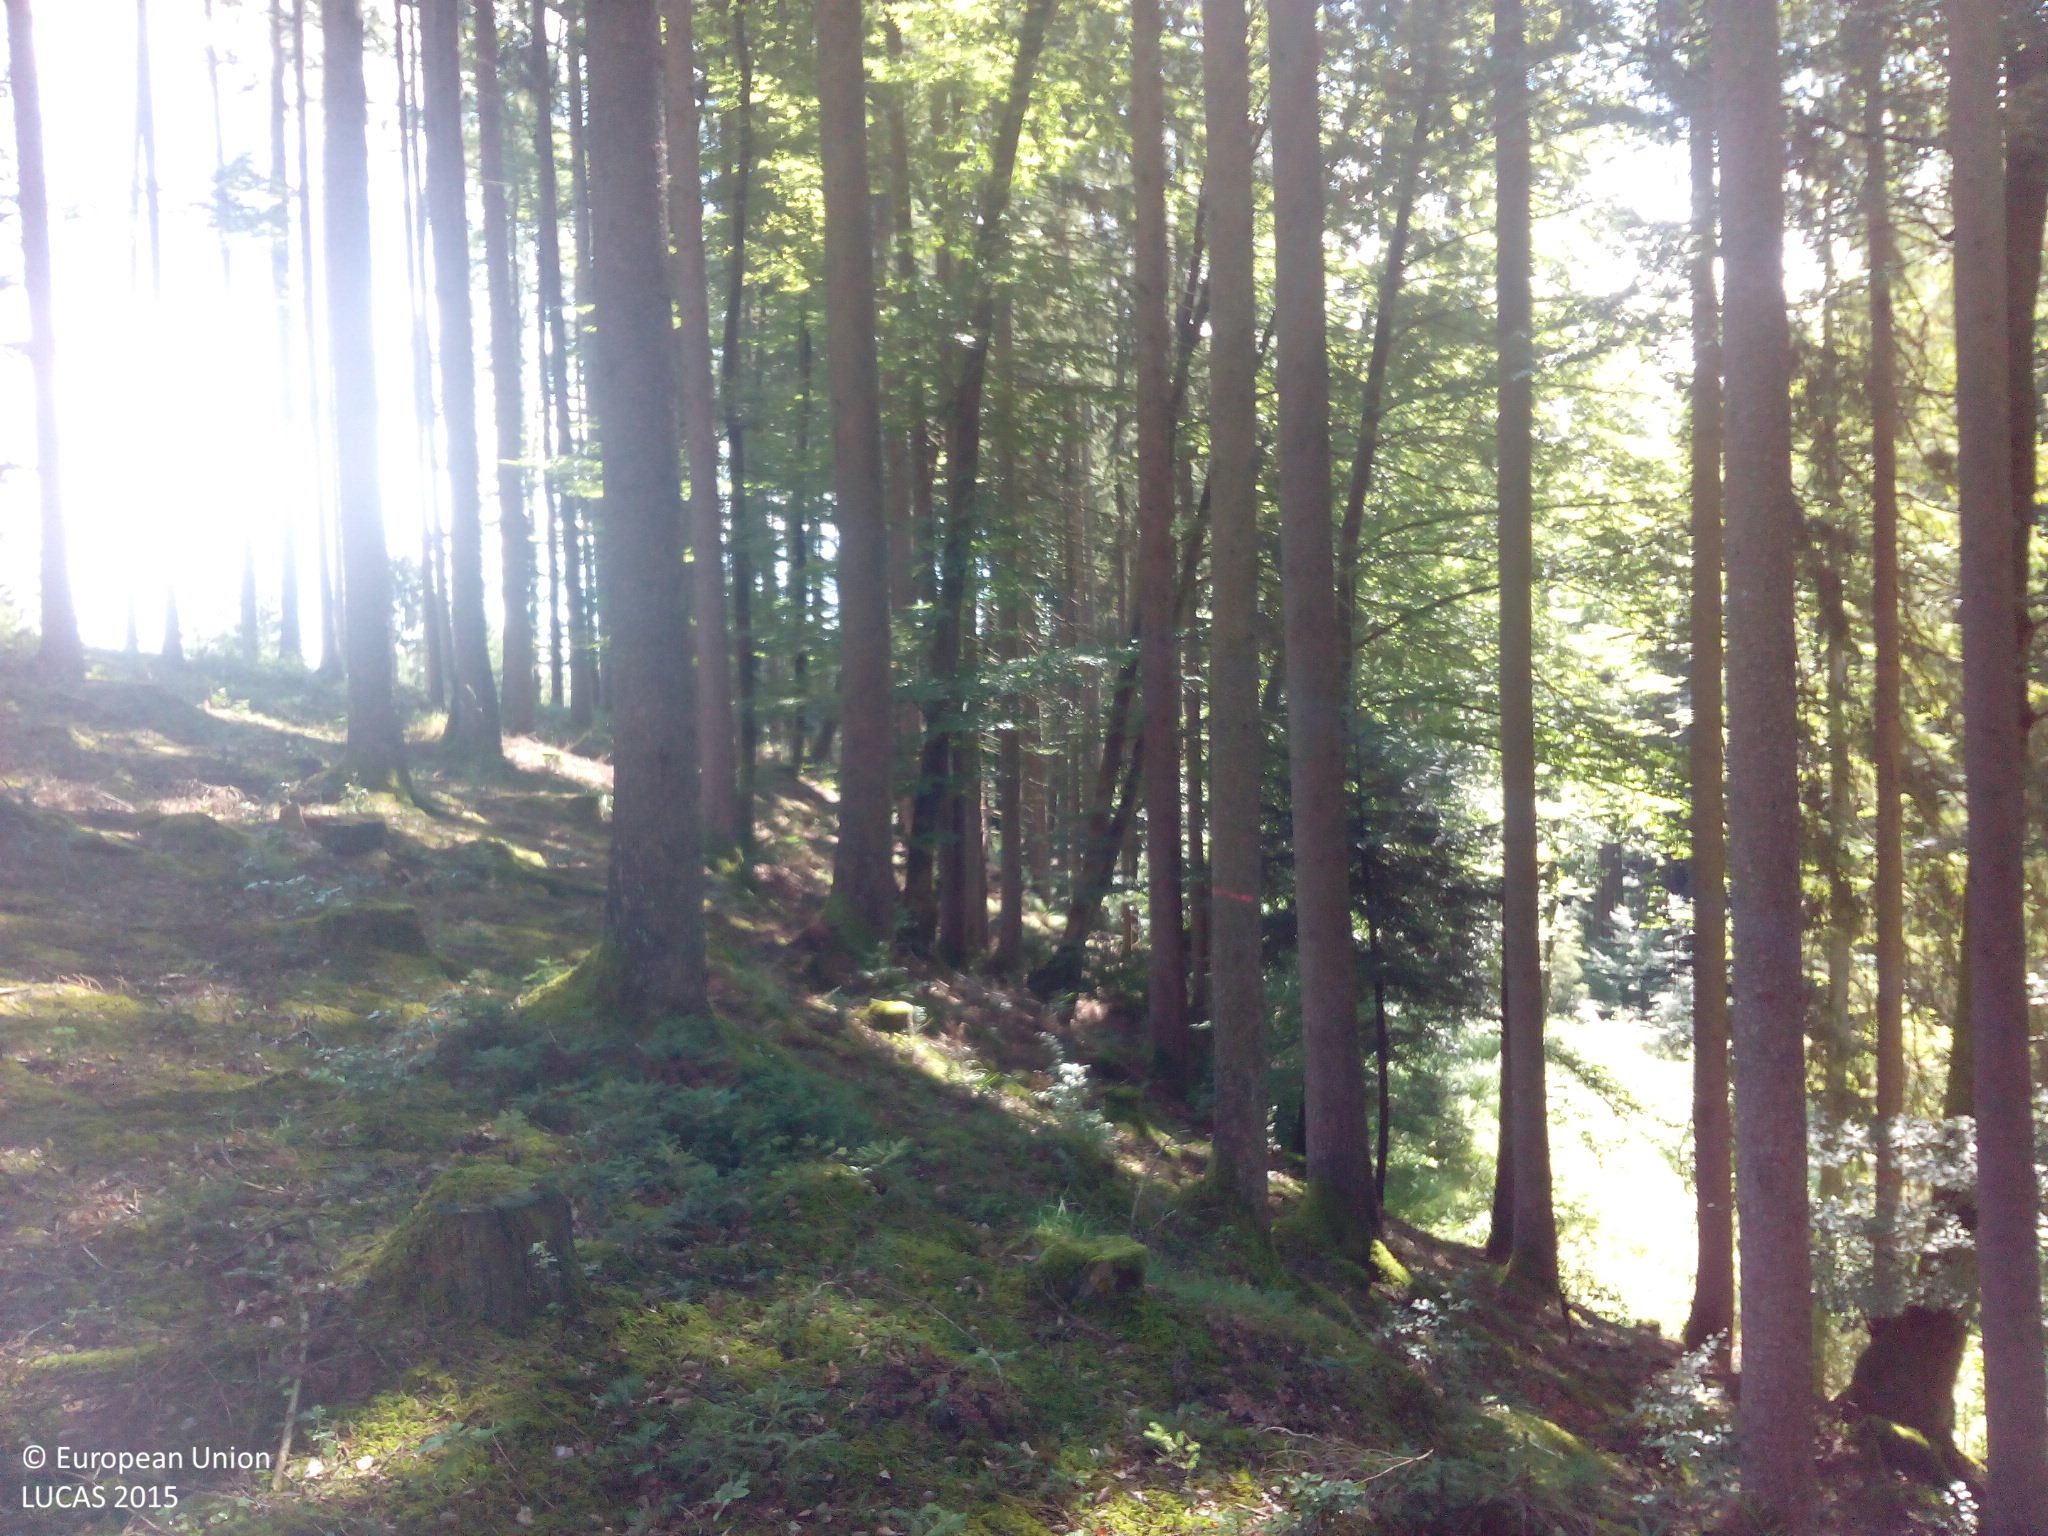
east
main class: Woodland
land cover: Spruce dominated coniferous woodland
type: hemiboreal forest and nemoral coniferous forest and mixed broadleaved-coniferous forest
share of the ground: > 75 %
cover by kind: coniferous forest trees 95 %, broadleaved forest trees 5 %
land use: Forestry
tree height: > 5 m
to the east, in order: Spruce dominated coniferous woodland; Tracks; Spontaneously vegetated surfaces; Spruce dominated mixed woodland; Tracks; Spruce dominated coniferous woodland; Tracks; Spruce dominated mixed woodland
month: July
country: DE
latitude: 47.8906
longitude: 11.4034
